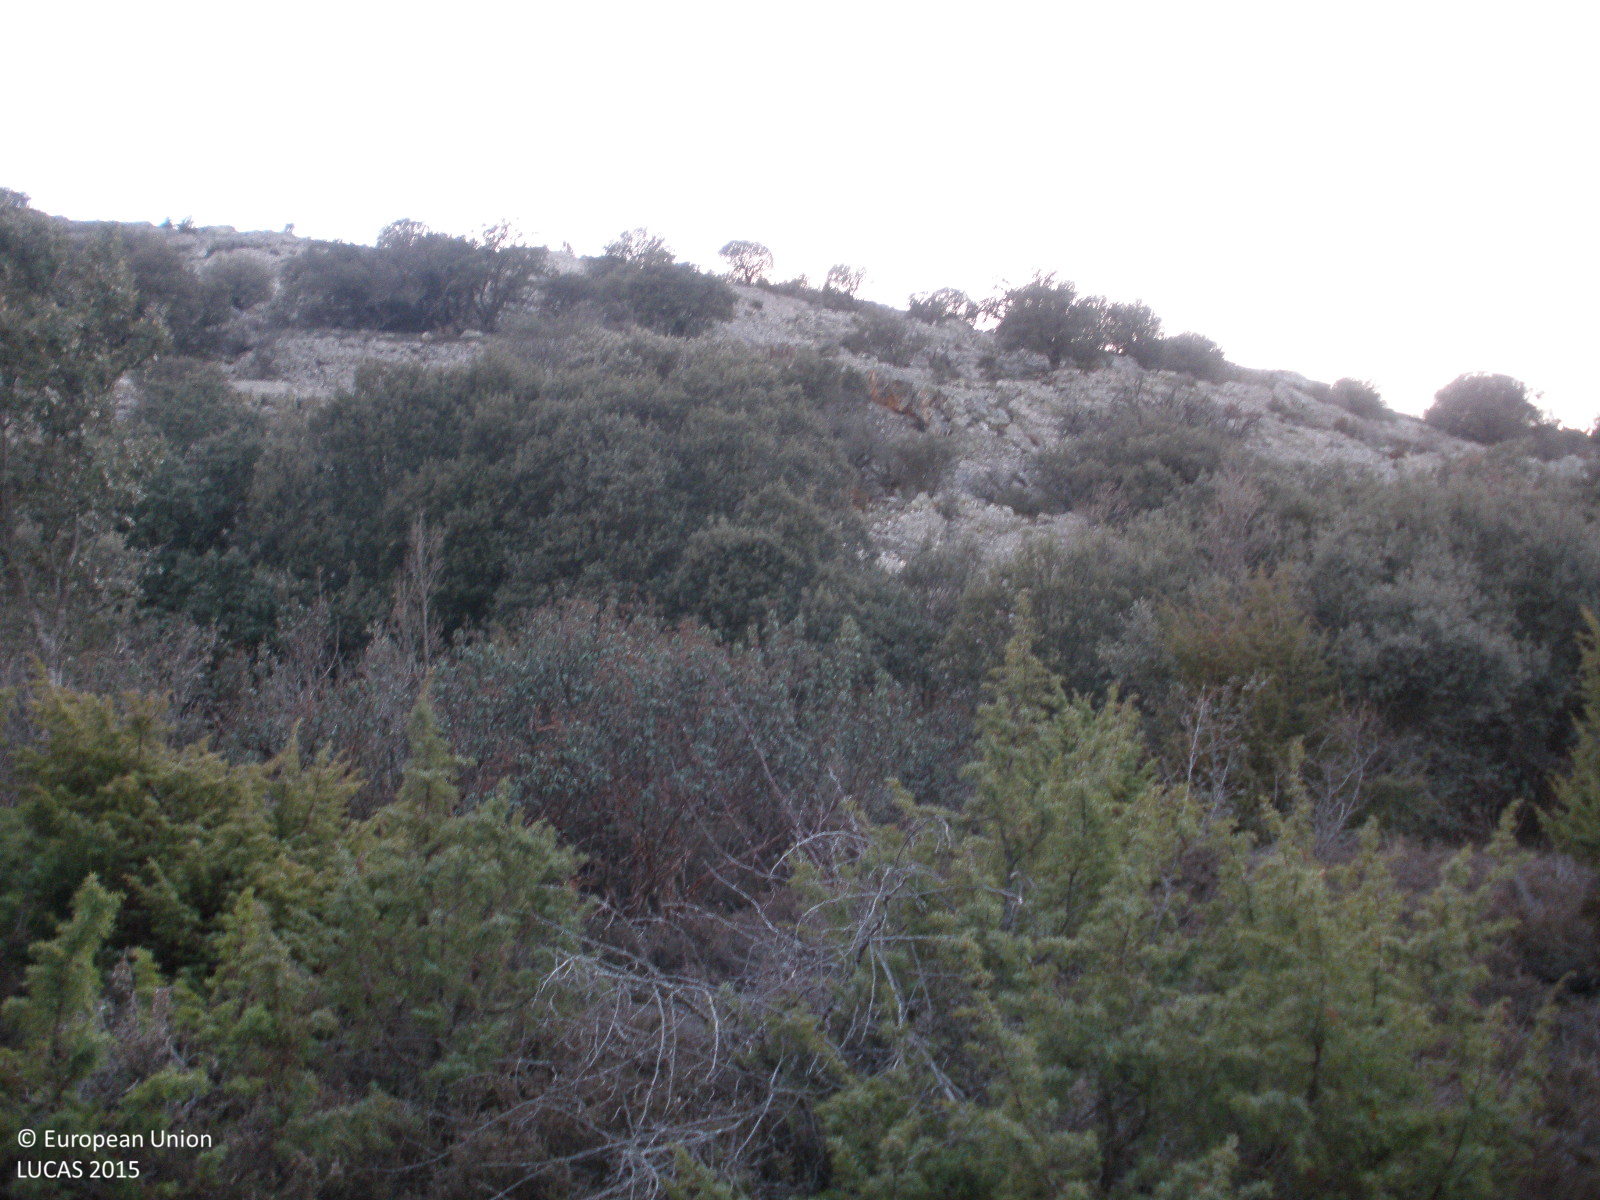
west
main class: Woodland
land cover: Other mixed woodland
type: coniferous forest of the mediterranean region
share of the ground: > 75 %
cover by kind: broadleaved forest trees 40 %, coniferous forest trees 30 %, shrubs 30 %
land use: Semi-natural and natural areas not in use
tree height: < 5 m
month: April
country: ES
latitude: 41.1042
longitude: -1.1759
